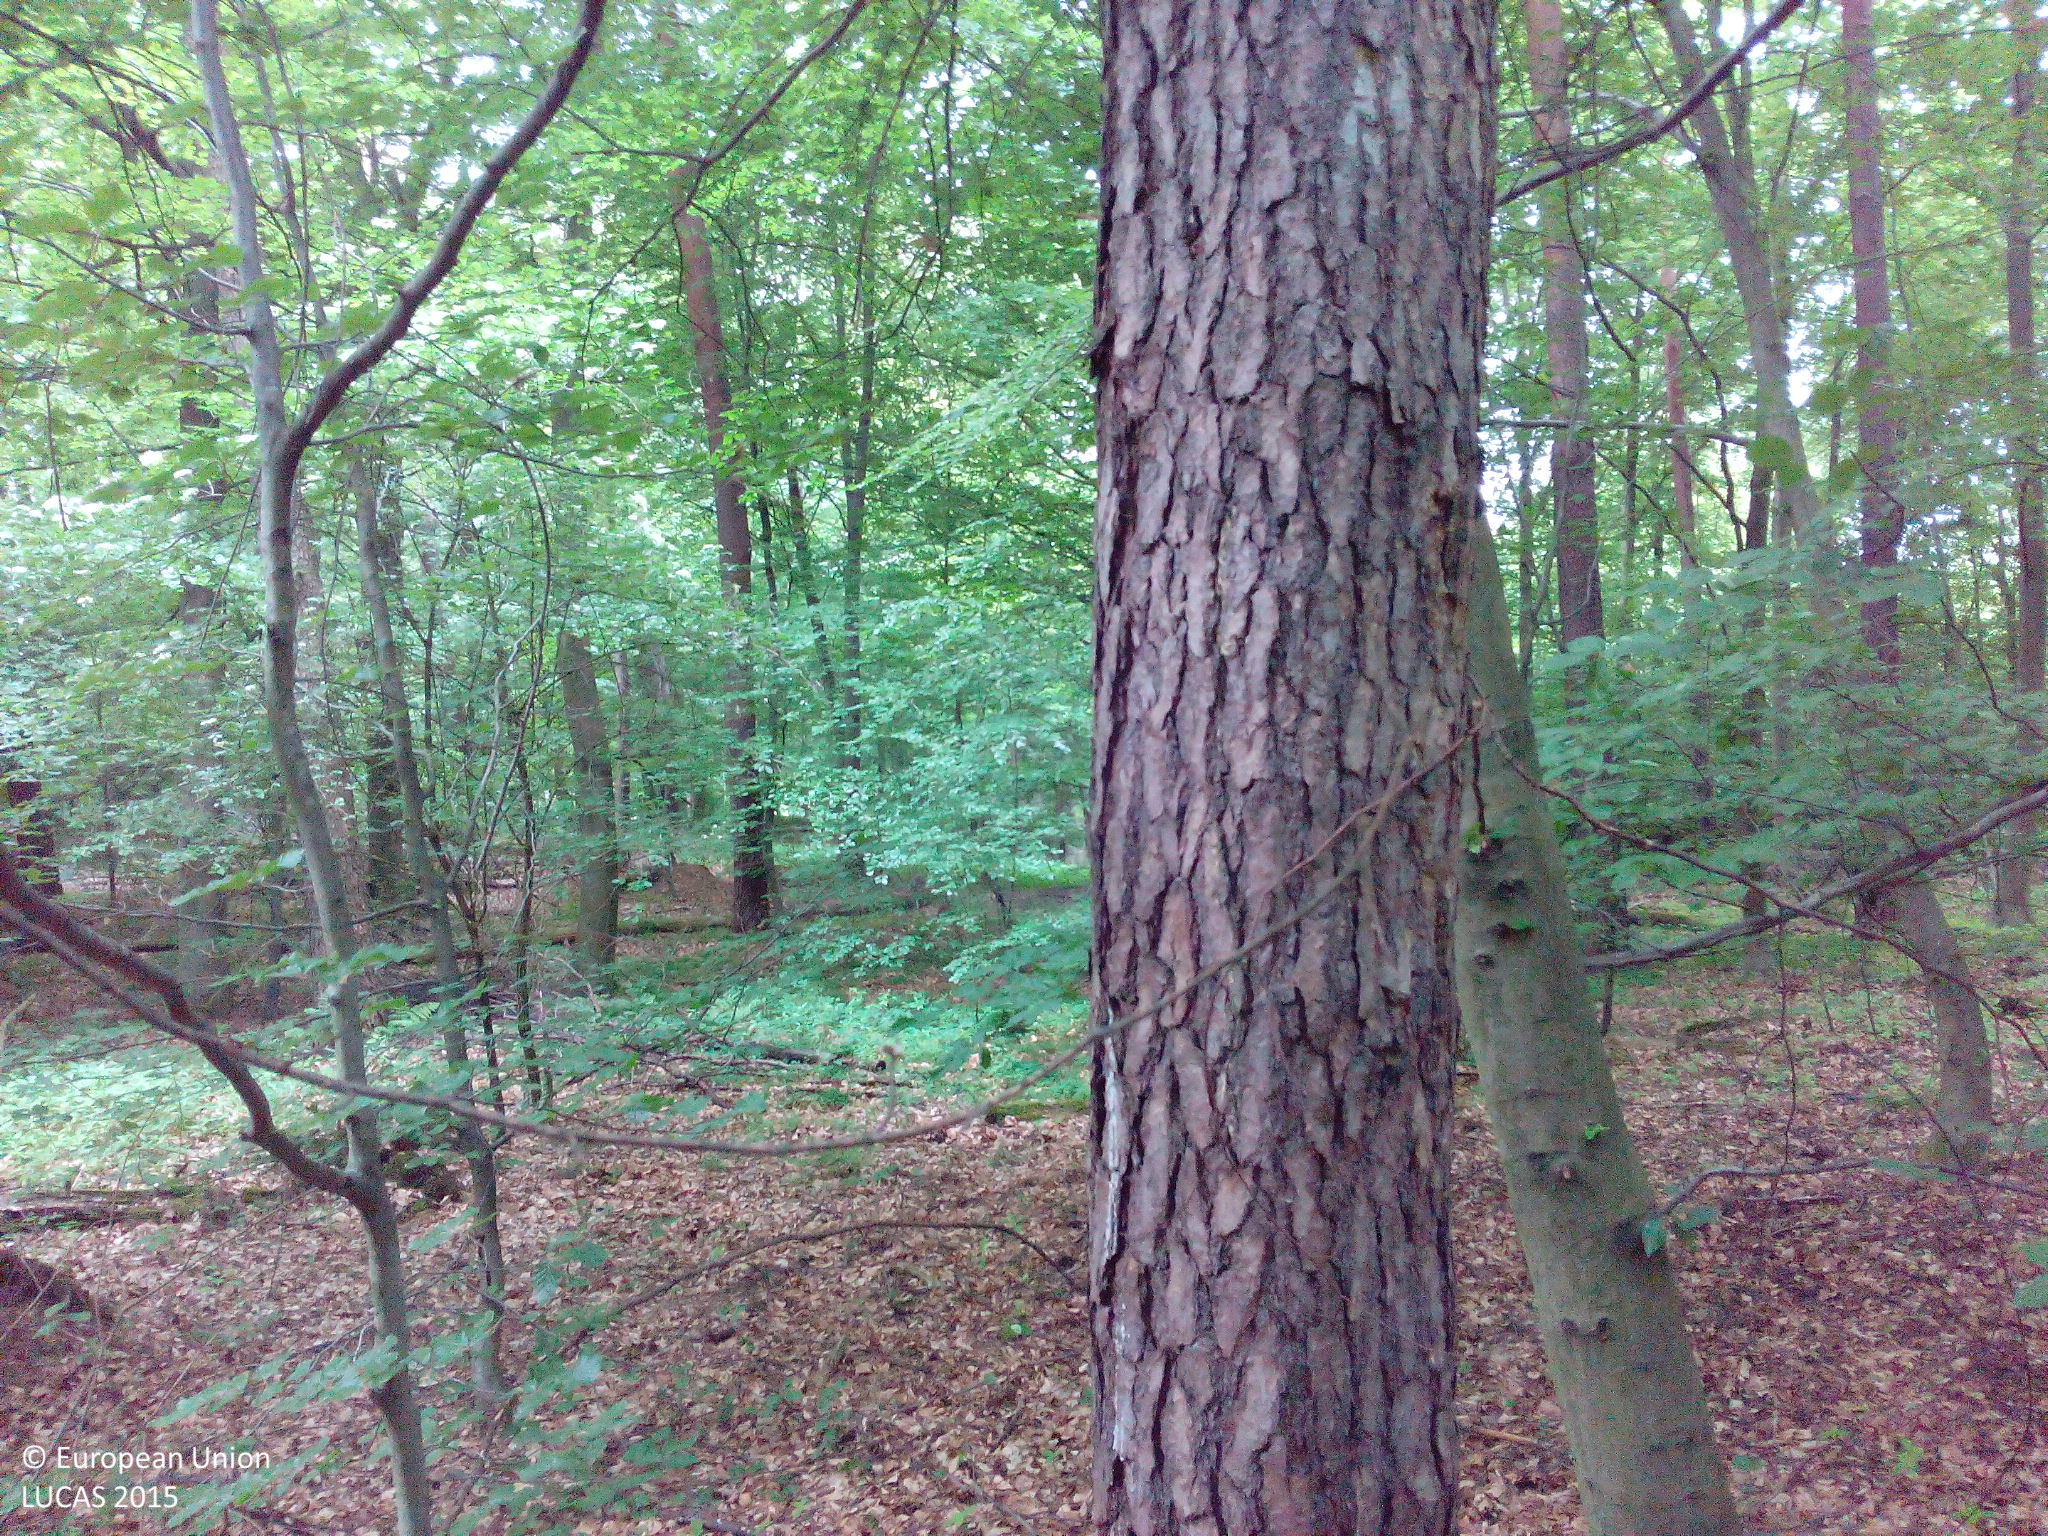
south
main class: Woodland
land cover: Broadleaved woodland
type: beech forest
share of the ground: > 75 %
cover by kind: broadleaved forest trees 85 %, coniferous forest trees 5 %, herbaceous plants 5 %, unconsolidated bare surface 5 %
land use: Forestry
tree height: > 5 m
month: May
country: DE
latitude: 48.7837
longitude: 8.1361
